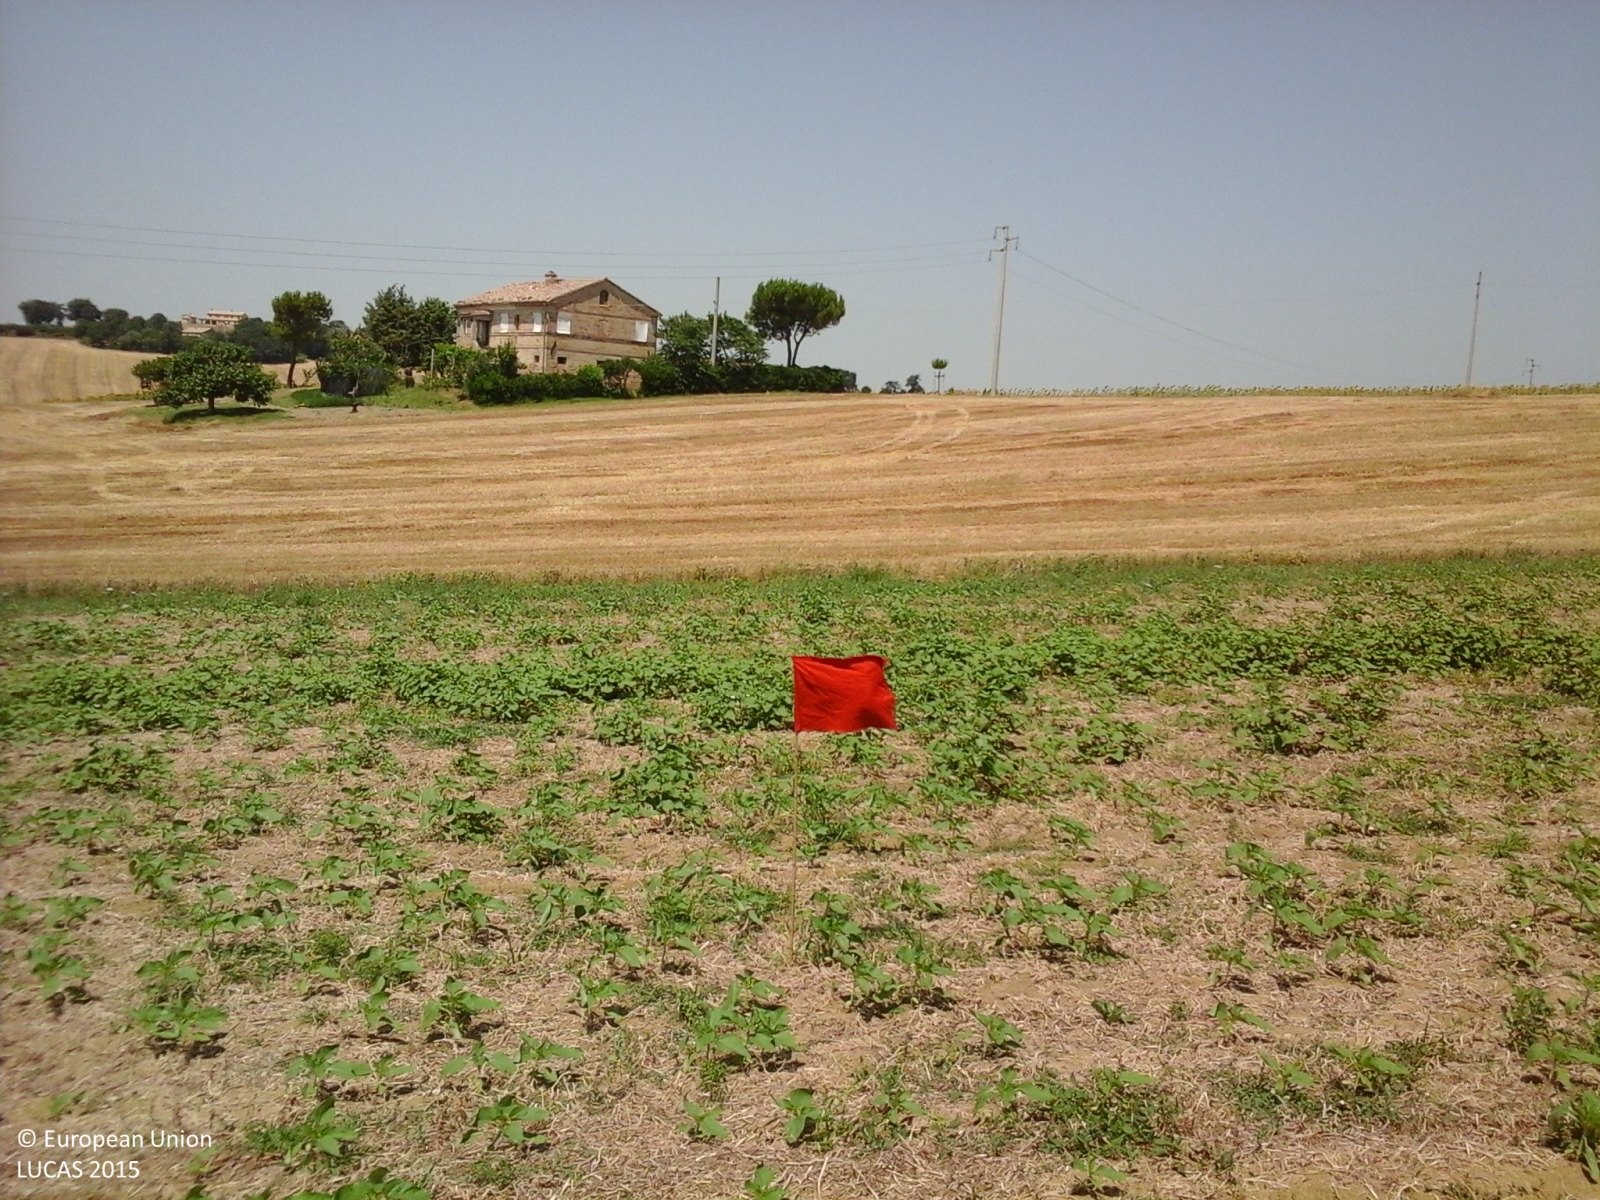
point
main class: Cropland
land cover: Sunflower
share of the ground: 25 - 50 %
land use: Agriculture (excluding fallow land and kitchen gardens)
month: July
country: IT
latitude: 43.3892
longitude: 13.4849
